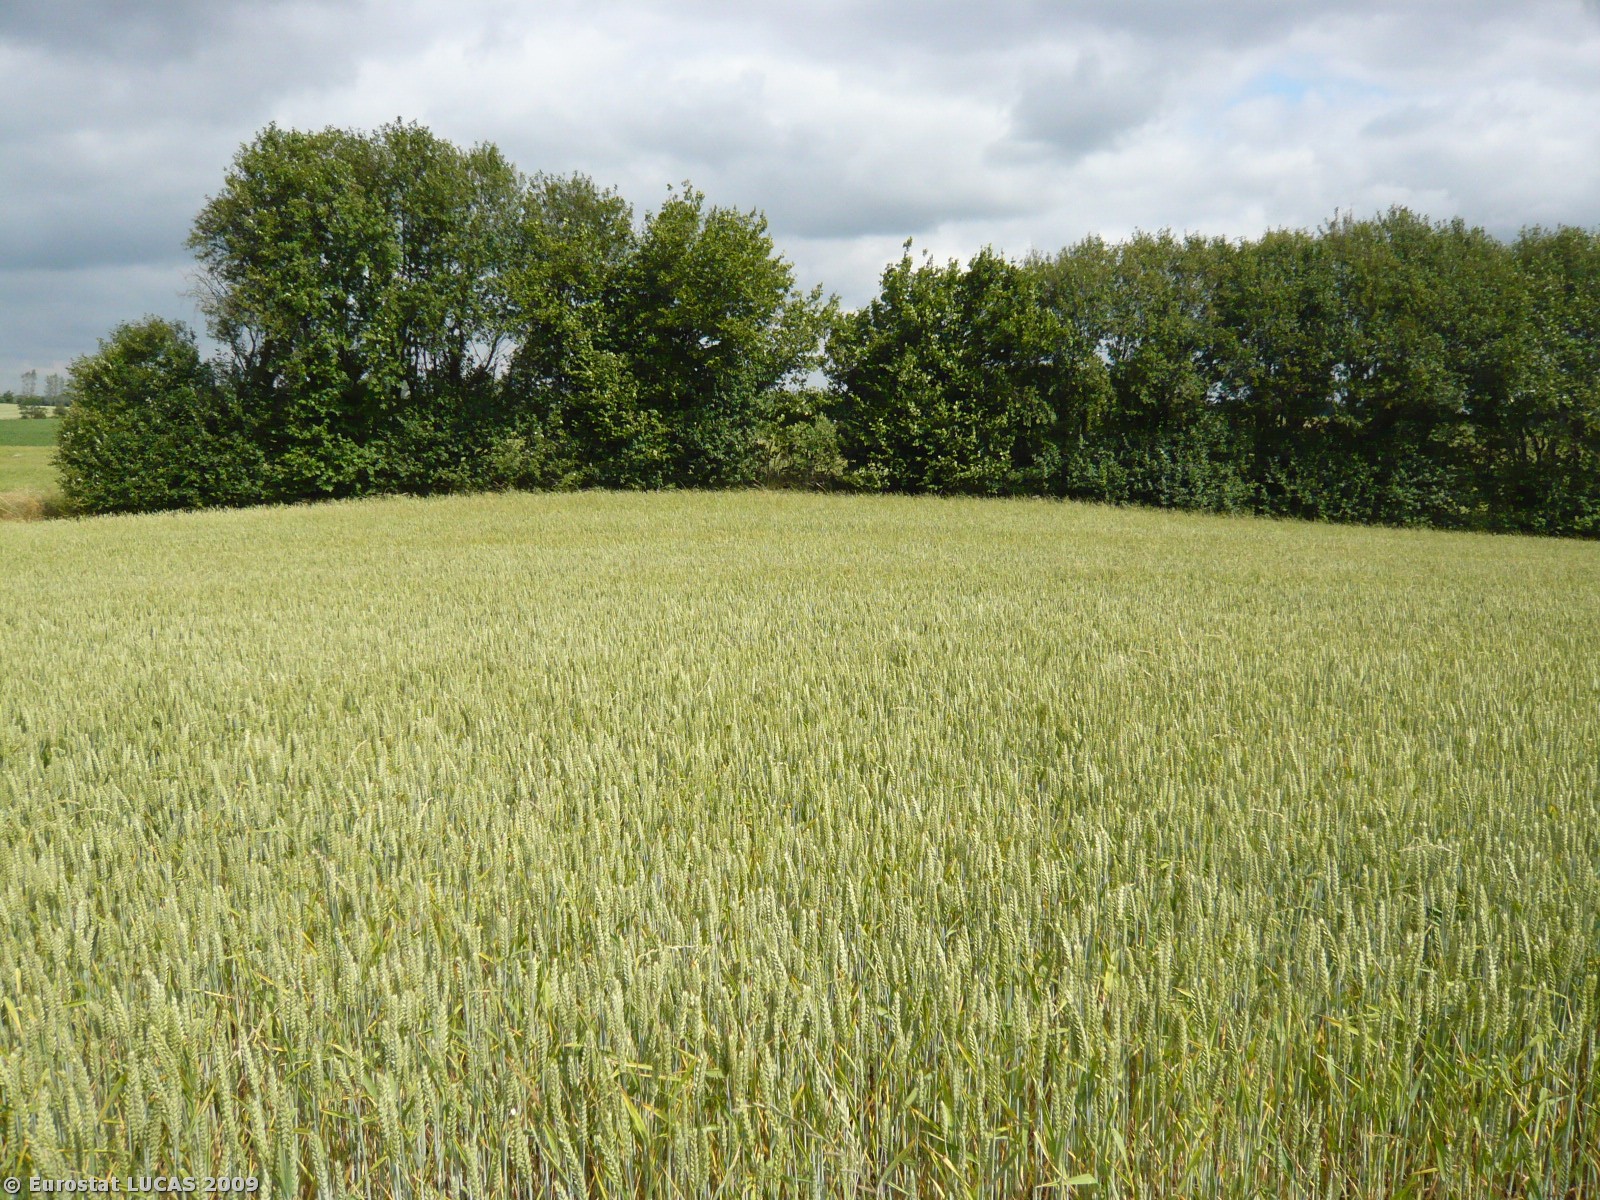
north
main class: Cropland
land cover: Common wheat
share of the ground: > 75 %
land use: Agriculture (excluding fallow land and kitchen gardens)
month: June
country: DK
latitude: 55.2709
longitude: 10.1730
